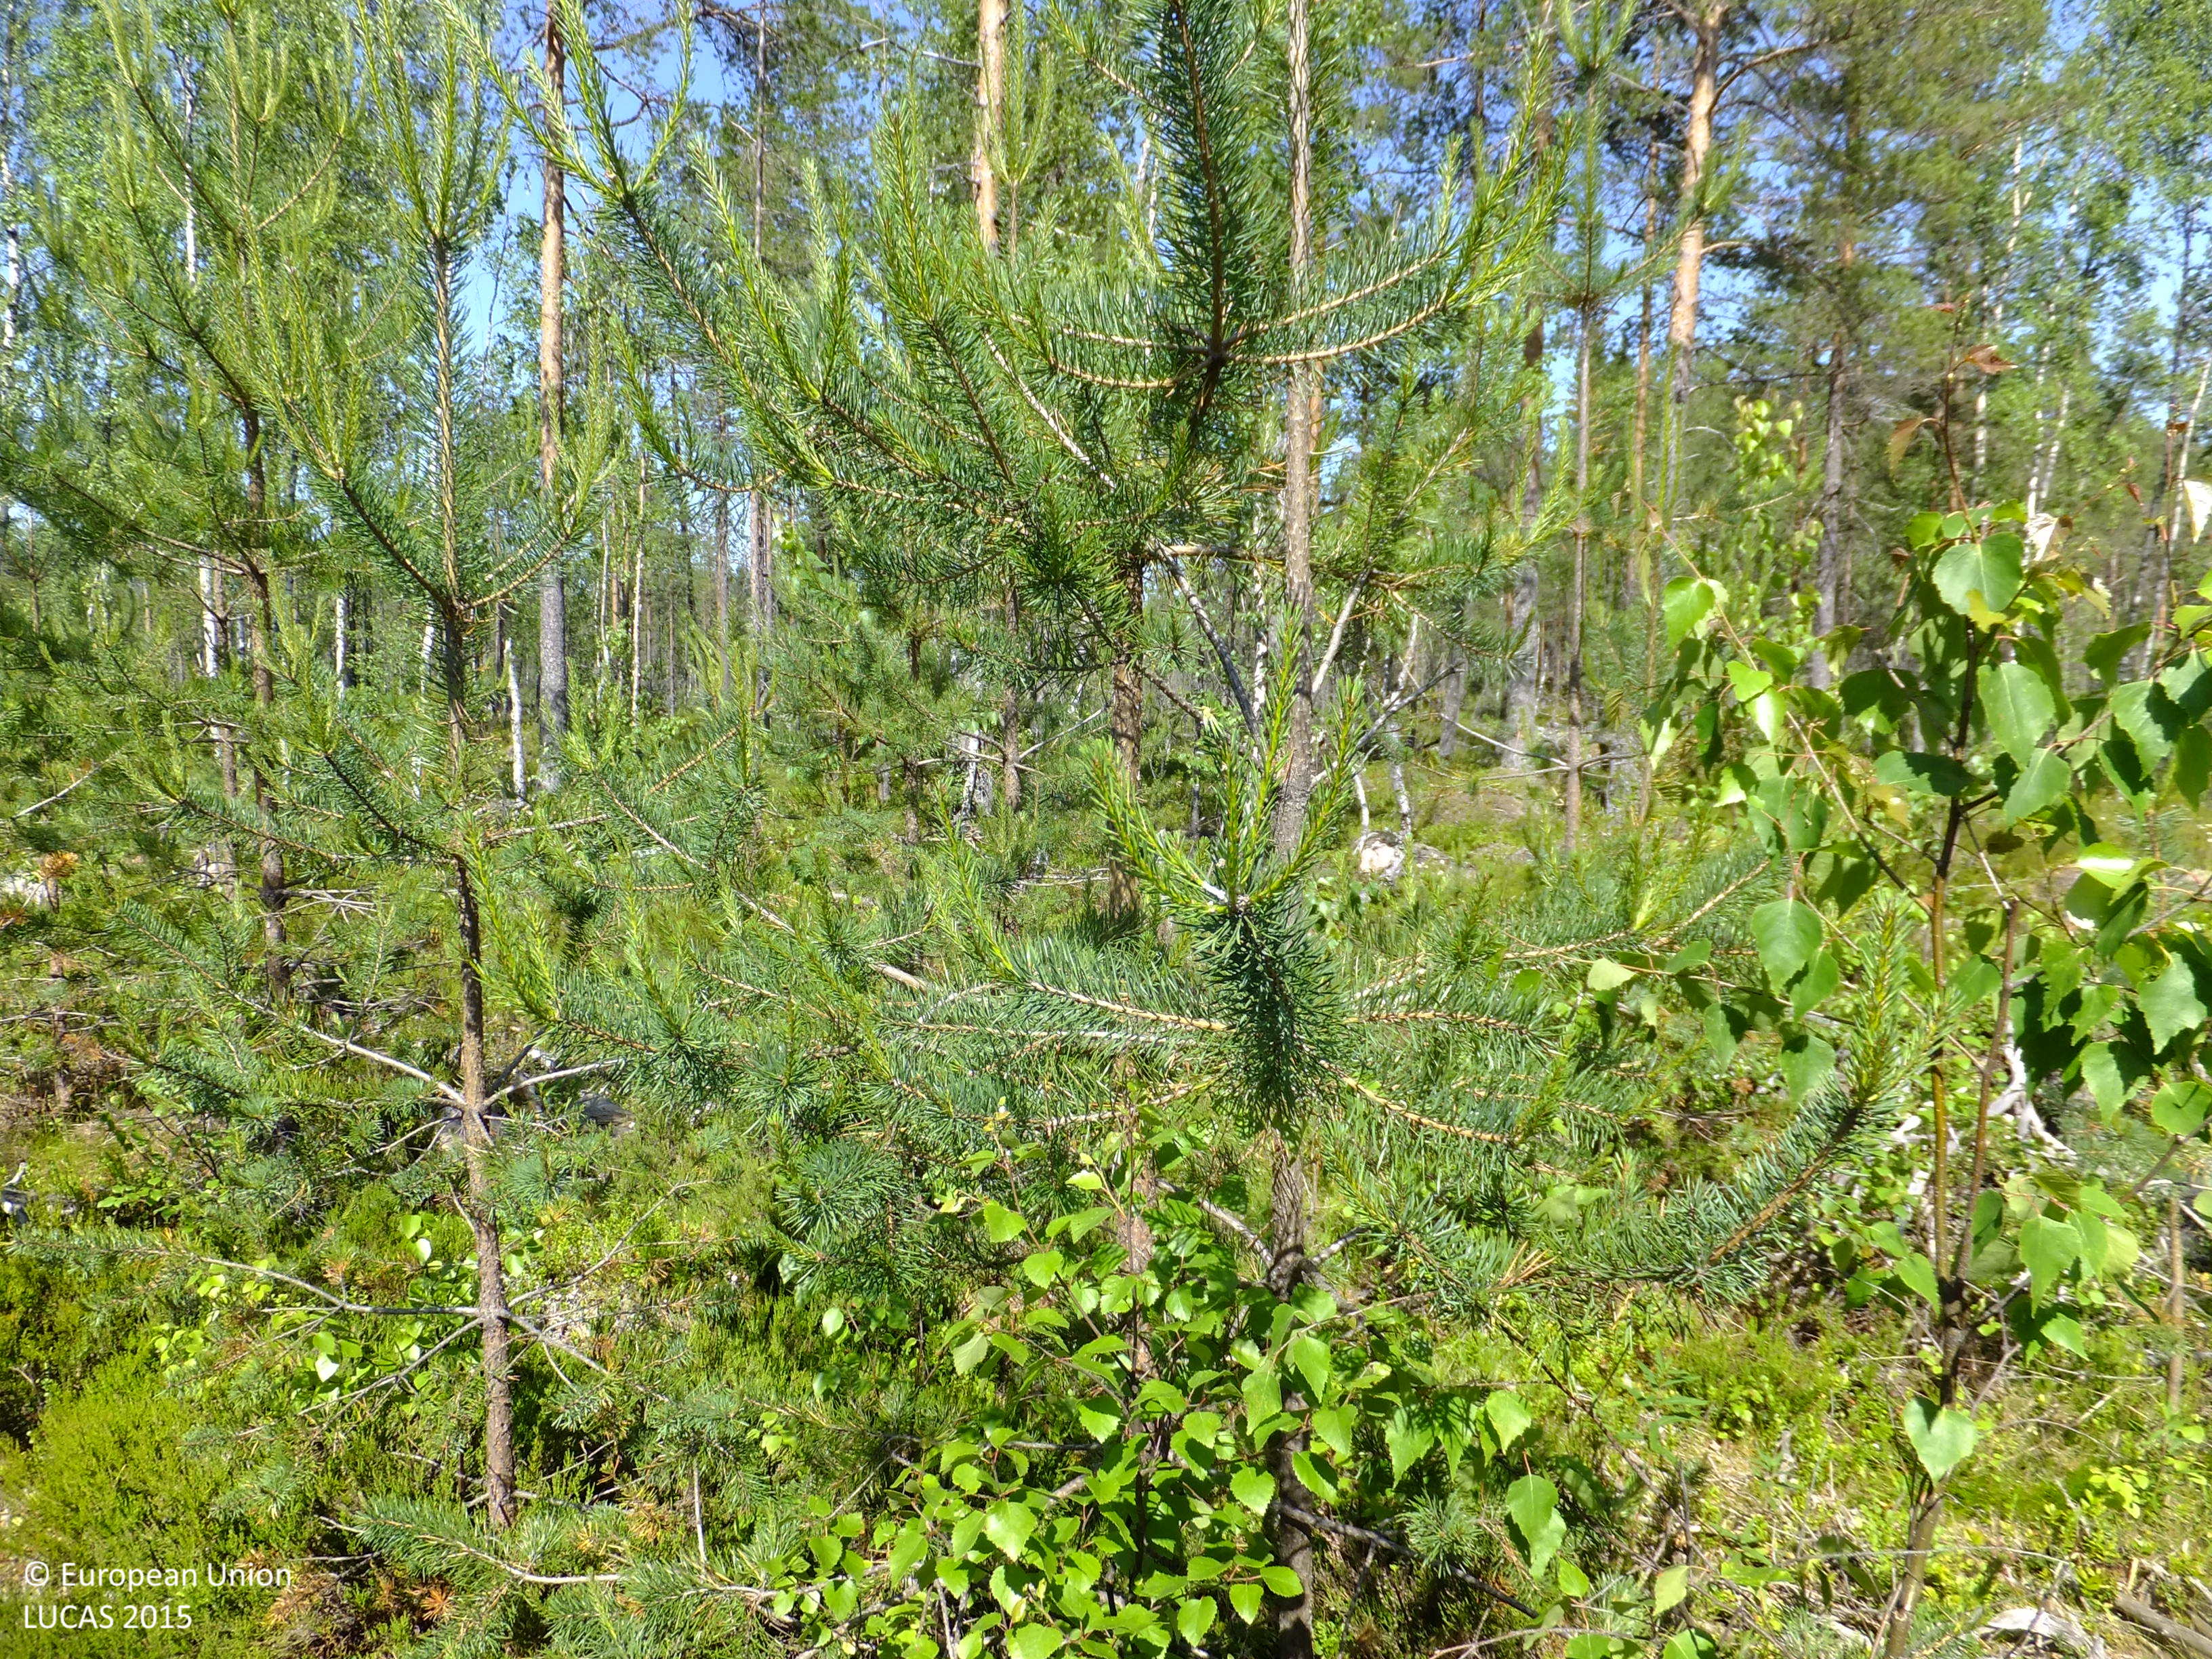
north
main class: Woodland
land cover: Pine dominated mixed woodland
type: boreal forest
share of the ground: 25 - 50 %
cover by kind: shrubs 40 %, coniferous forest trees 25 %, broadleaved forest trees 15 %, herbaceous plants 10 %, lichens and mosses 10 %
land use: Forestry
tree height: < 5 m
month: July
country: FI
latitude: 63.2744
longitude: 24.6141
